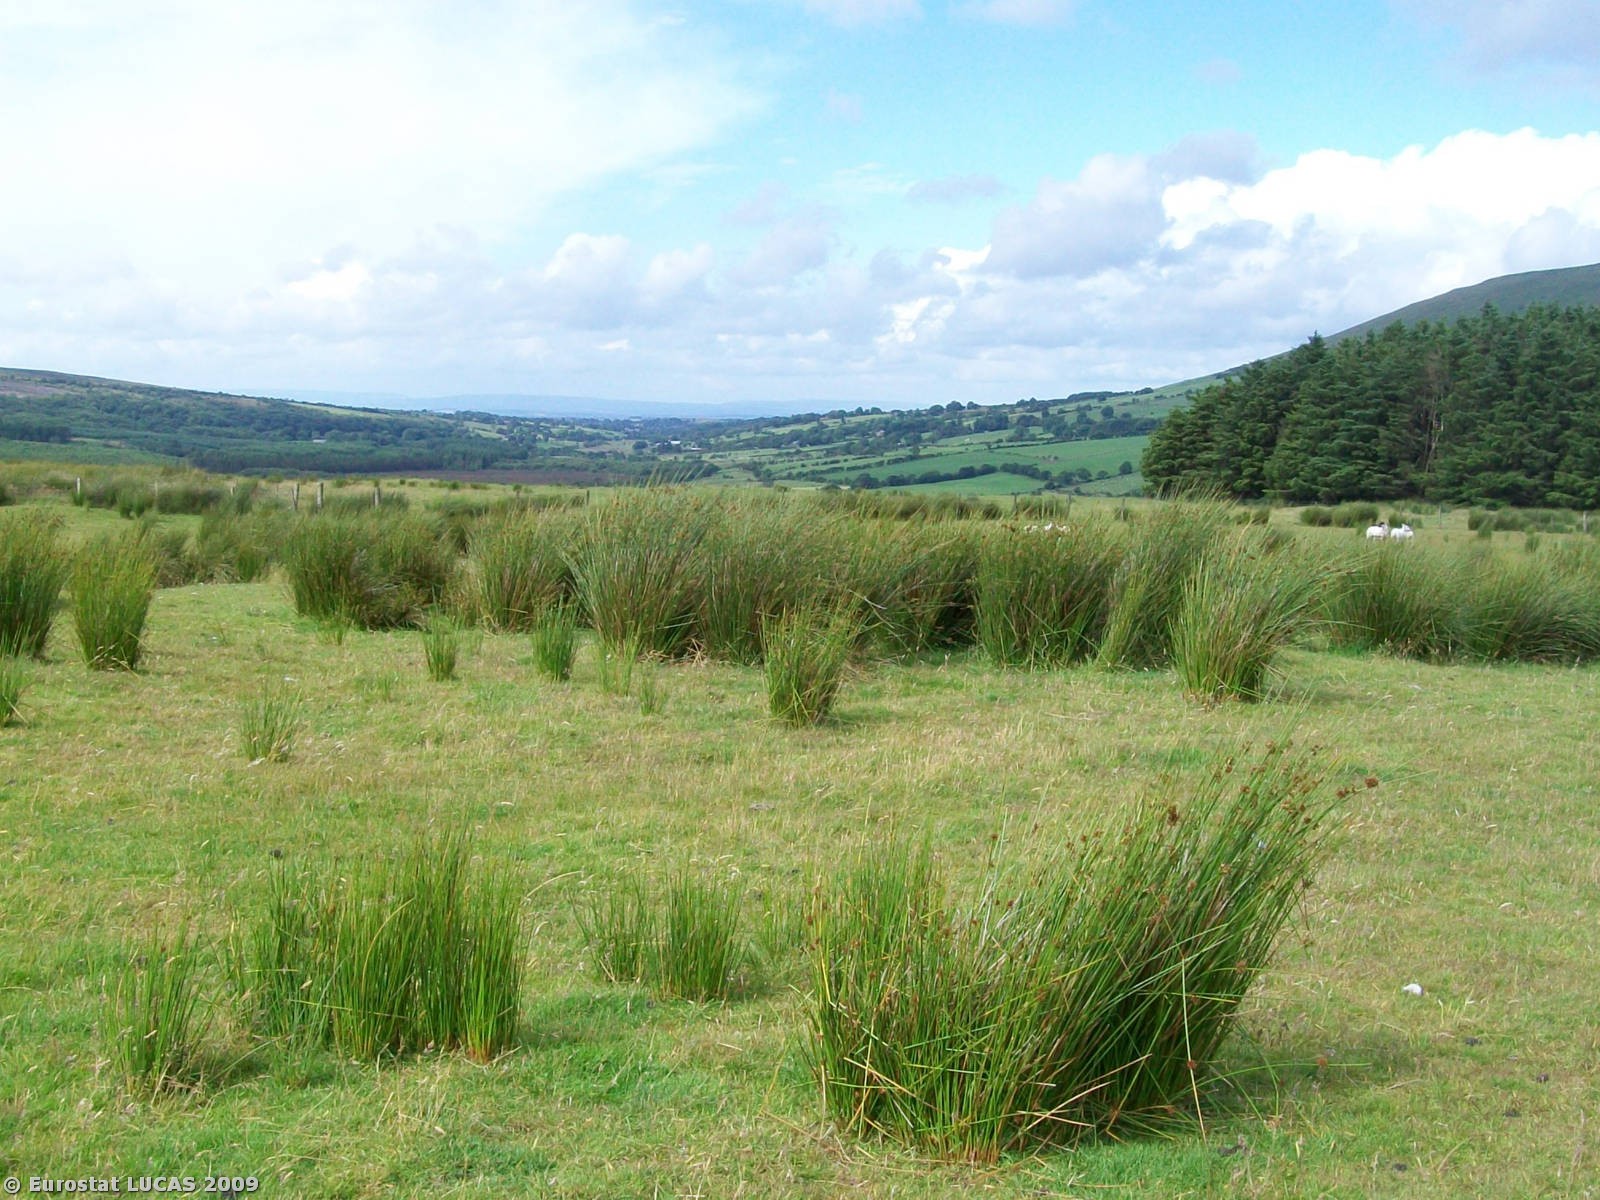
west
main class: Grassland
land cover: Grassland without tree/shrub cover
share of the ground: > 75 %
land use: Agriculture (excluding fallow land and kitchen gardens)
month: July
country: GB
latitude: 55.1484
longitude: -6.1965
